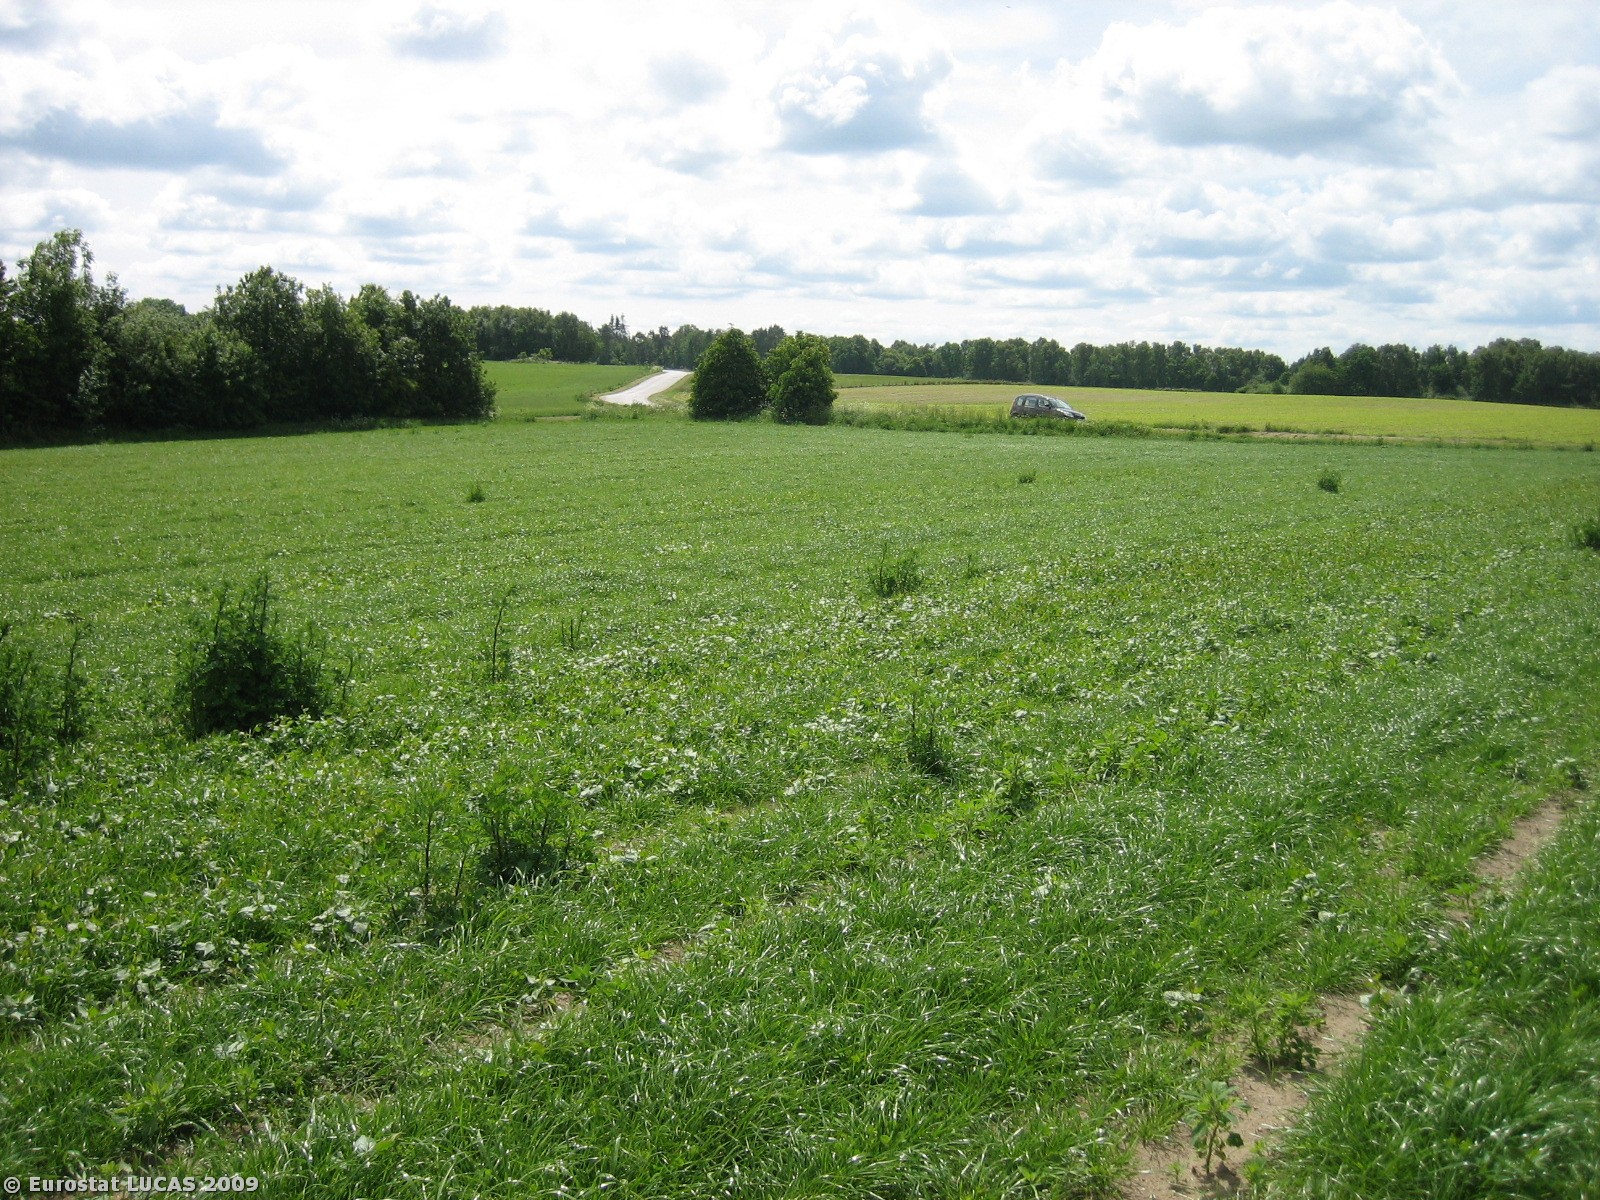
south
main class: Cropland
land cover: Temporary grasslands
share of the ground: 50 - 75 %
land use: Agriculture (excluding fallow land and kitchen gardens)
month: June
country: DK
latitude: 56.0617
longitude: 9.7915
